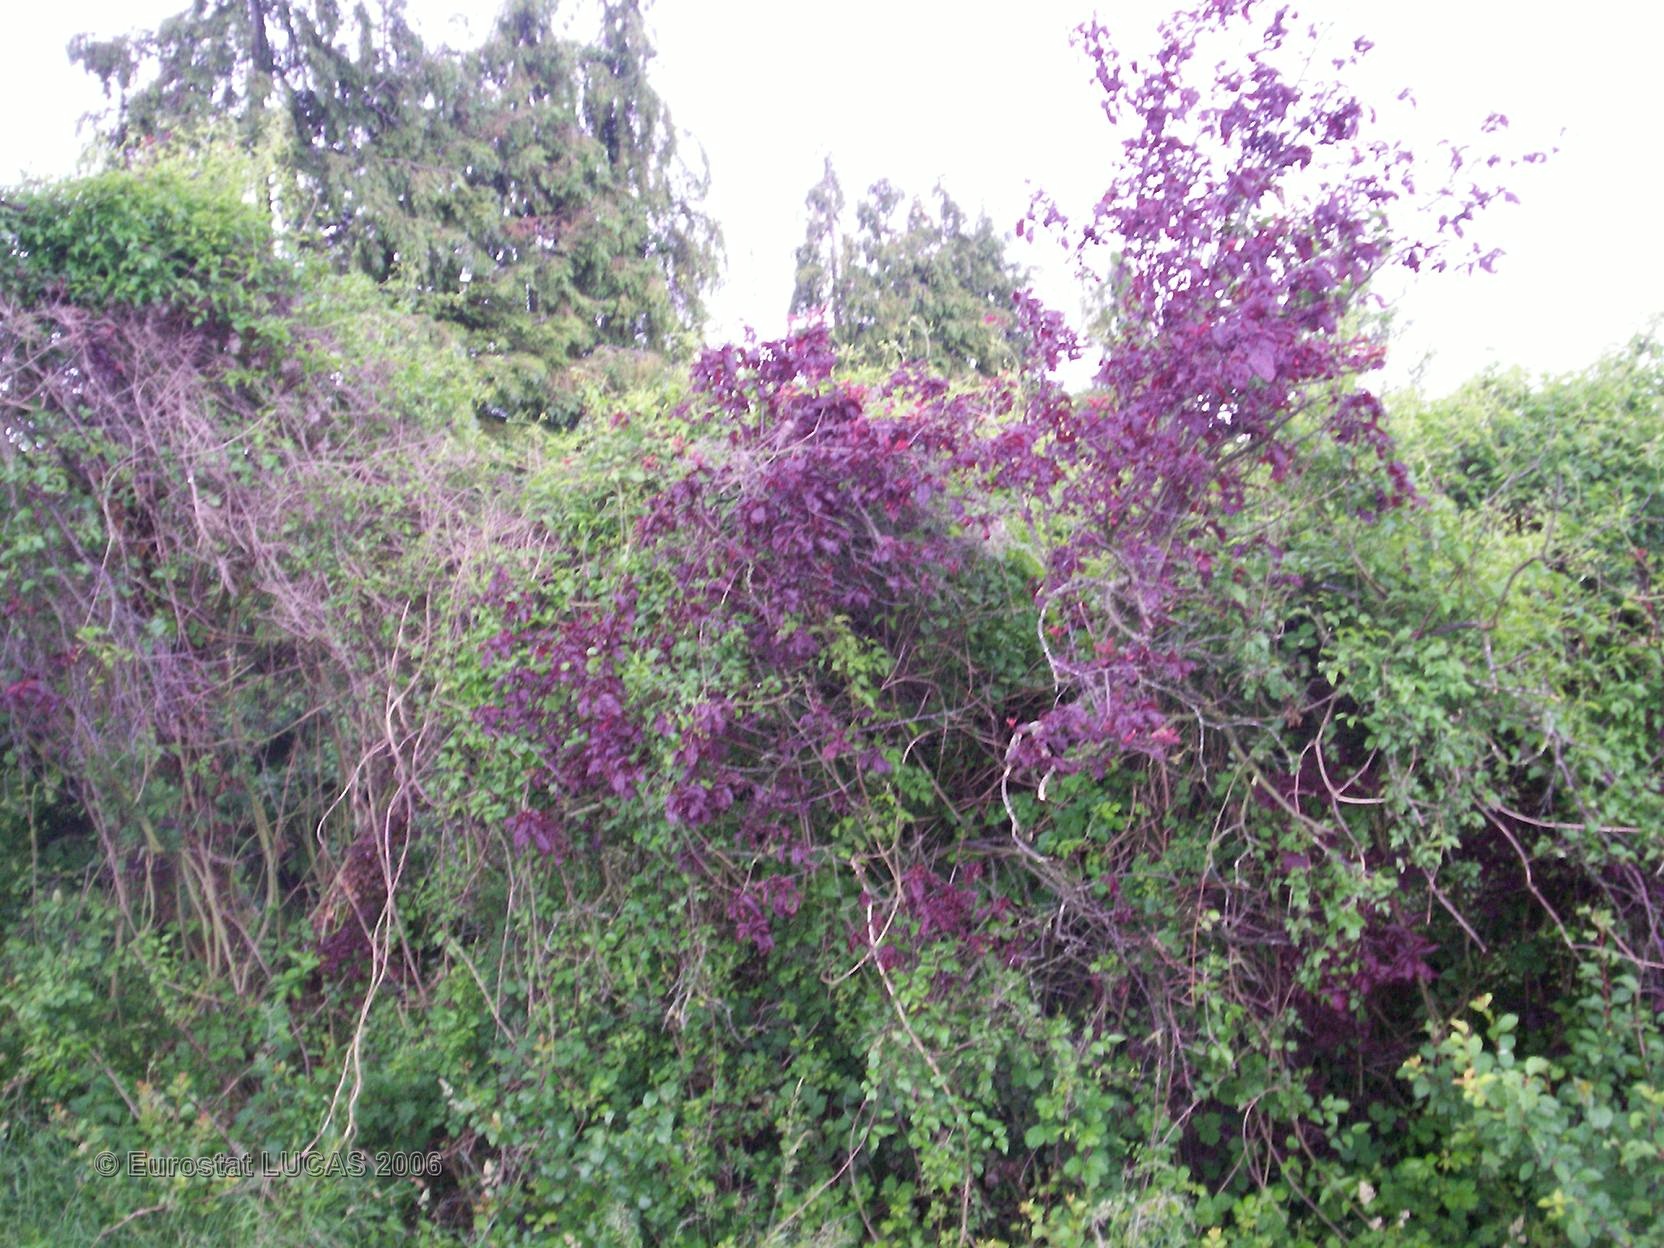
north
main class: Cropland
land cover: Rape and turnip rape
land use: Agriculture (excluding fallow land and kitchen gardens)
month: May
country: FR
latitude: 48.8751
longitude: 2.8322
